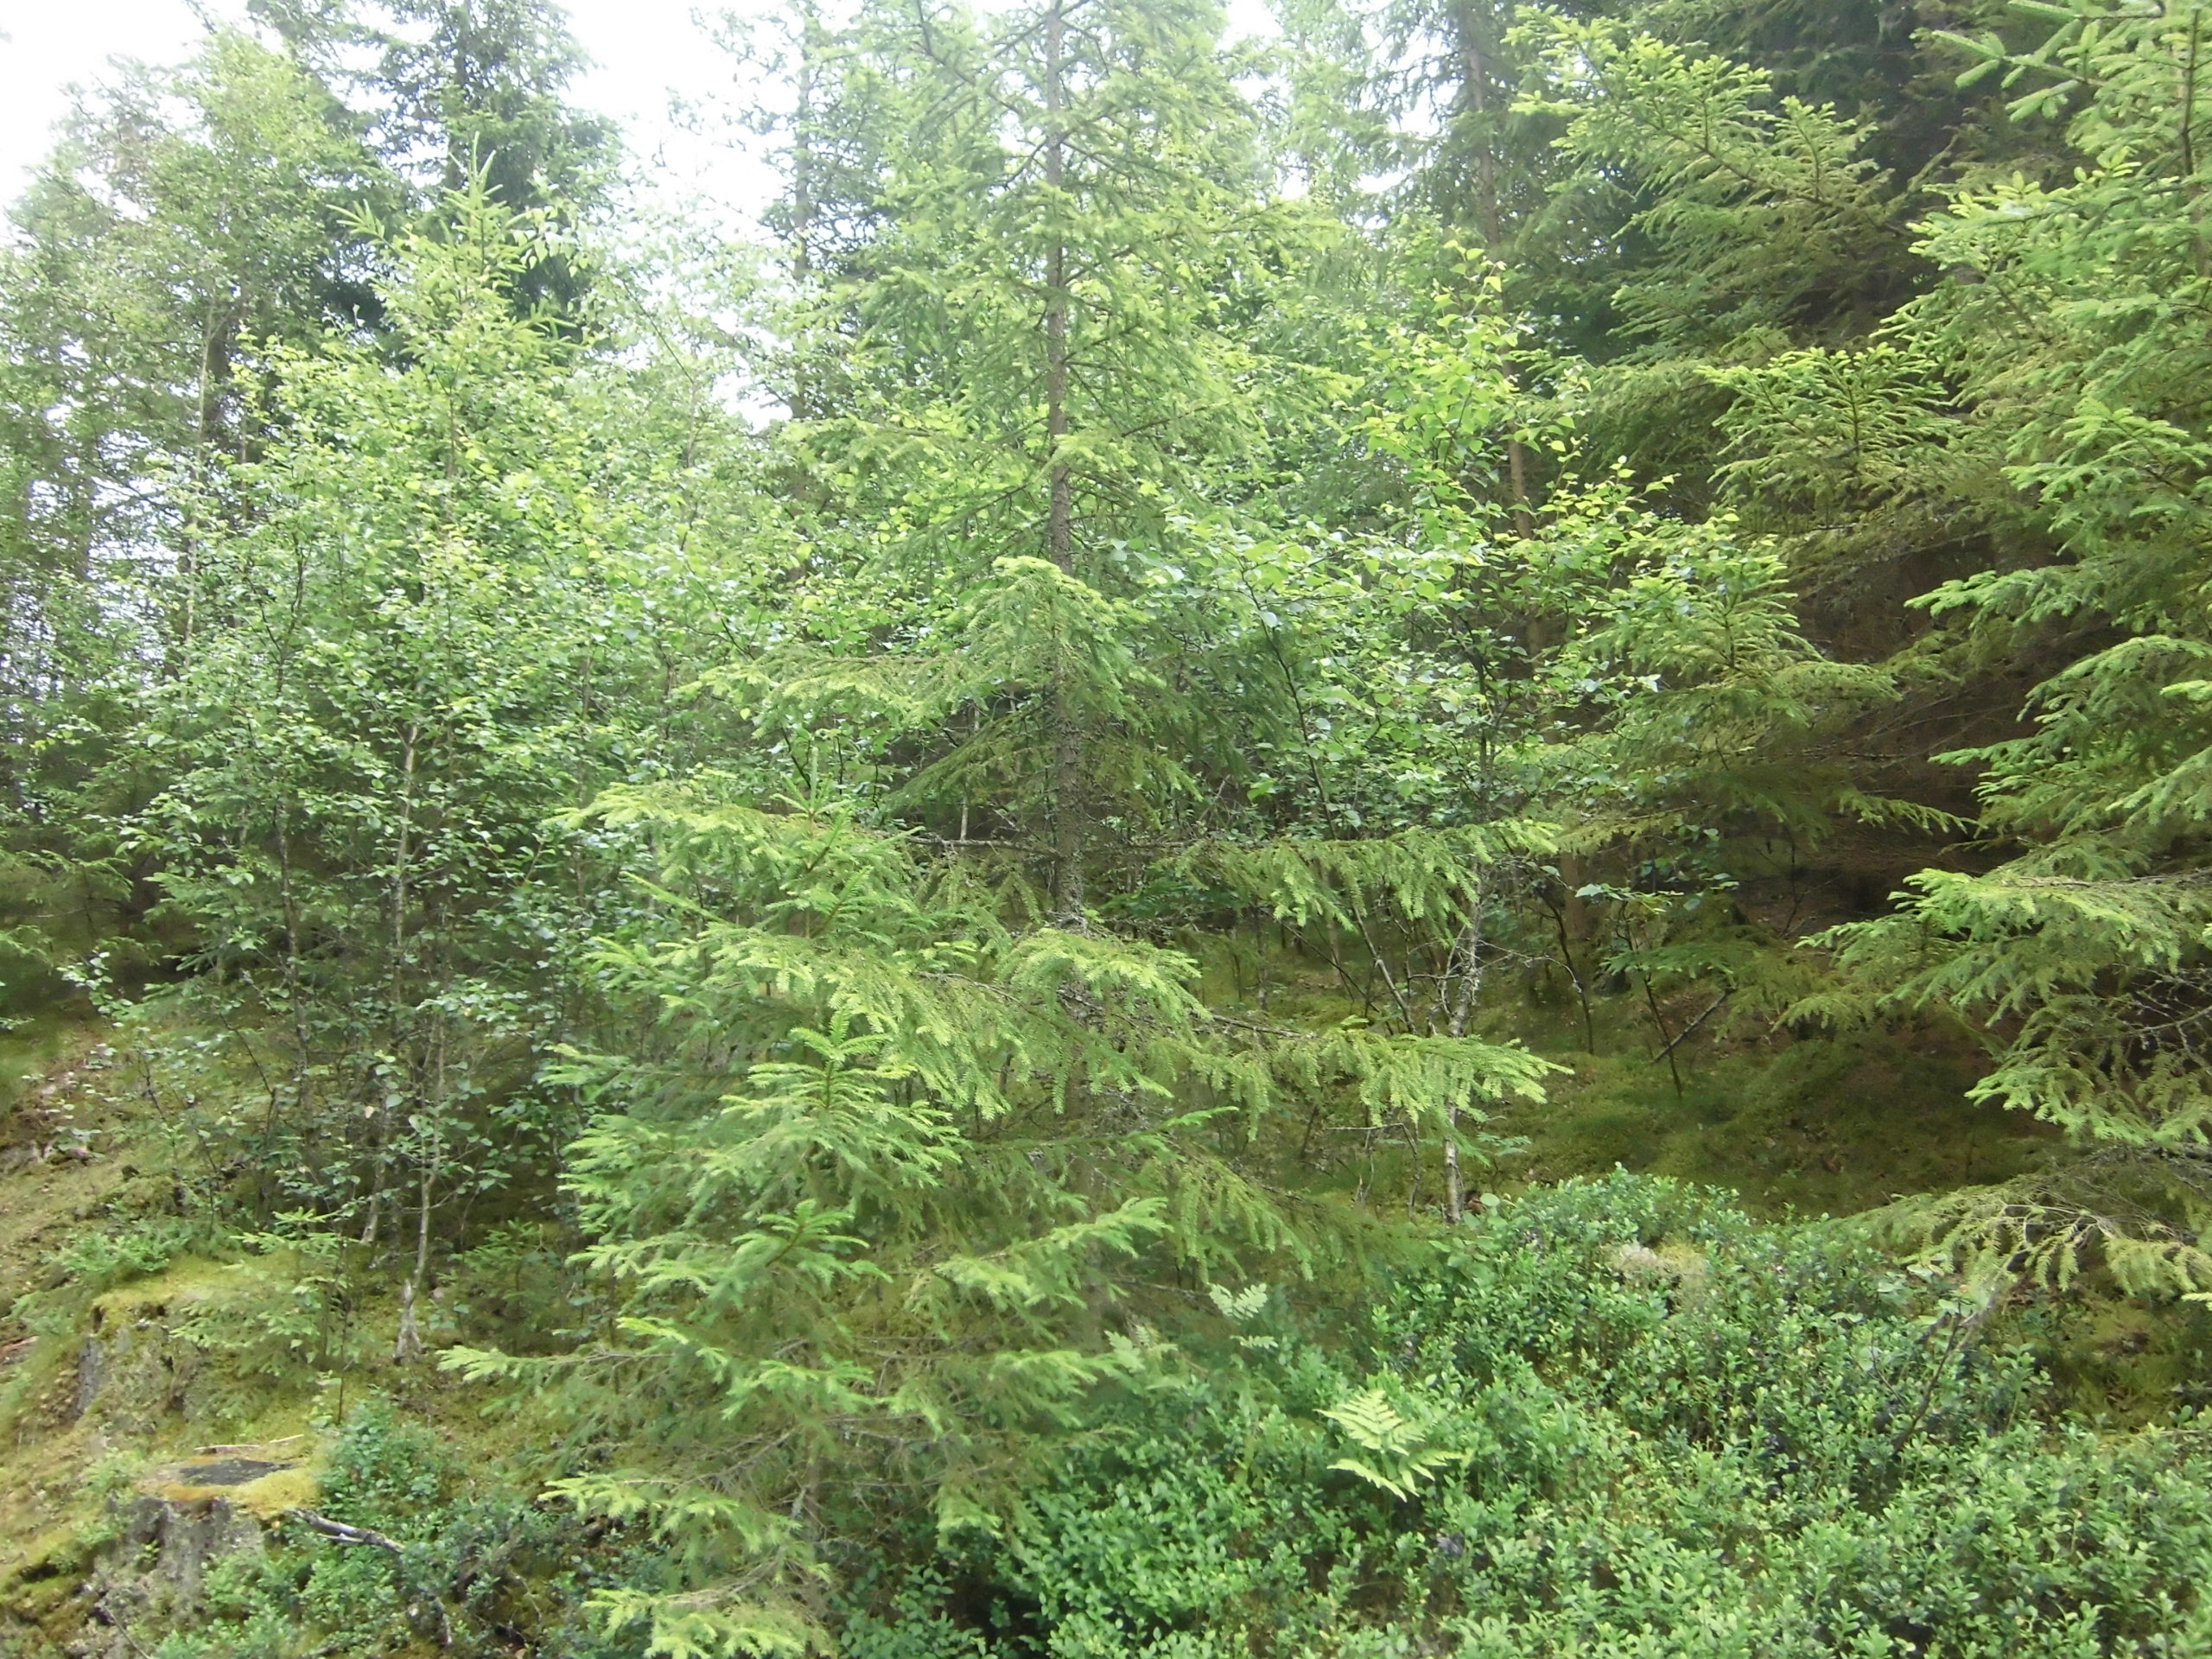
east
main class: Woodland
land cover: Spruce dominated mixed woodland
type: boreal forest
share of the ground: 50 - 75 %
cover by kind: coniferous forest trees 30 %, shrubs 25 %, broadleaved forest trees 20 %, lichens and mosses 15 %, herbaceous plants 10 %
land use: Forestry
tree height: > 5 m
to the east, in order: Spruce dominated mixed woodland; Spruce dominated coniferous woodland; Spruce dominated mixed woodland; Shrubland with sparse tree cover; Tracks; Shrubland with sparse tree cover; Spruce dominated mixed woodland
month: July
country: SE
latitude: 57.2723
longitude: 15.1876
